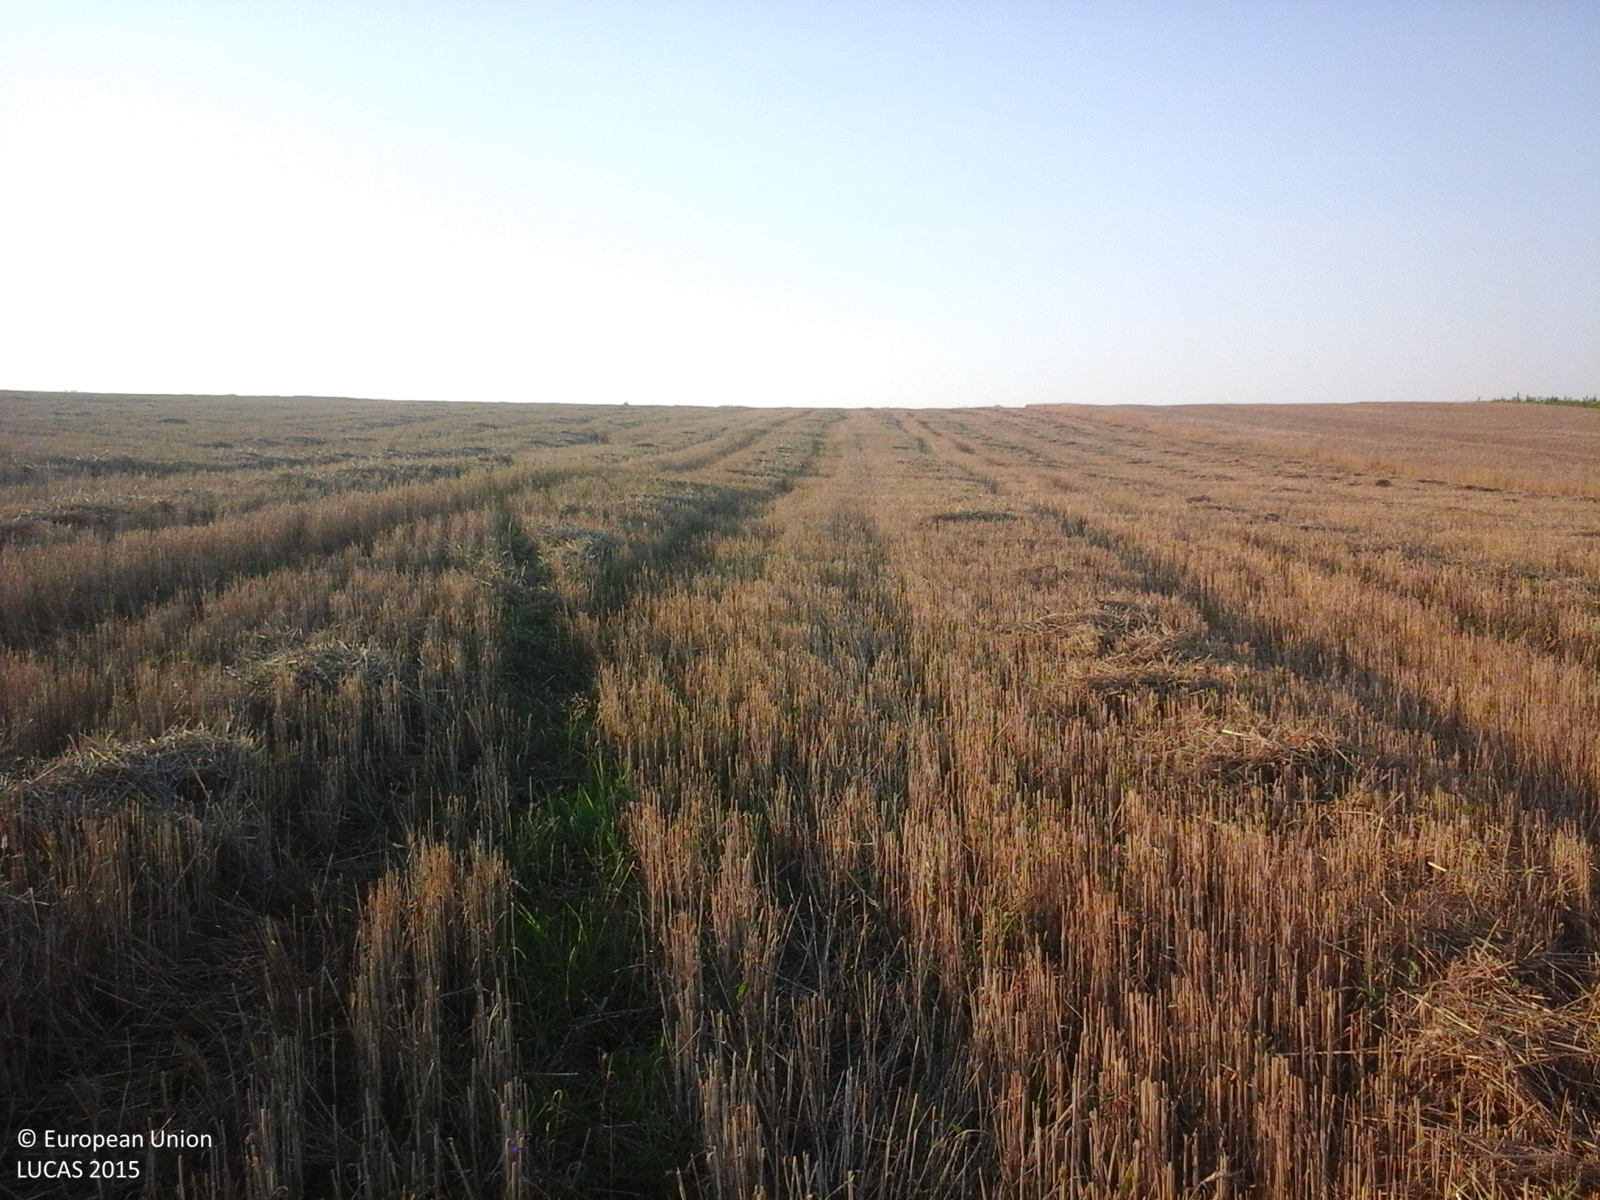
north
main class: Cropland
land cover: Common wheat
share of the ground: 50 - 75 %
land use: Agriculture (excluding fallow land and kitchen gardens)
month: July
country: RO
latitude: 44.2611
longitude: 24.4860
